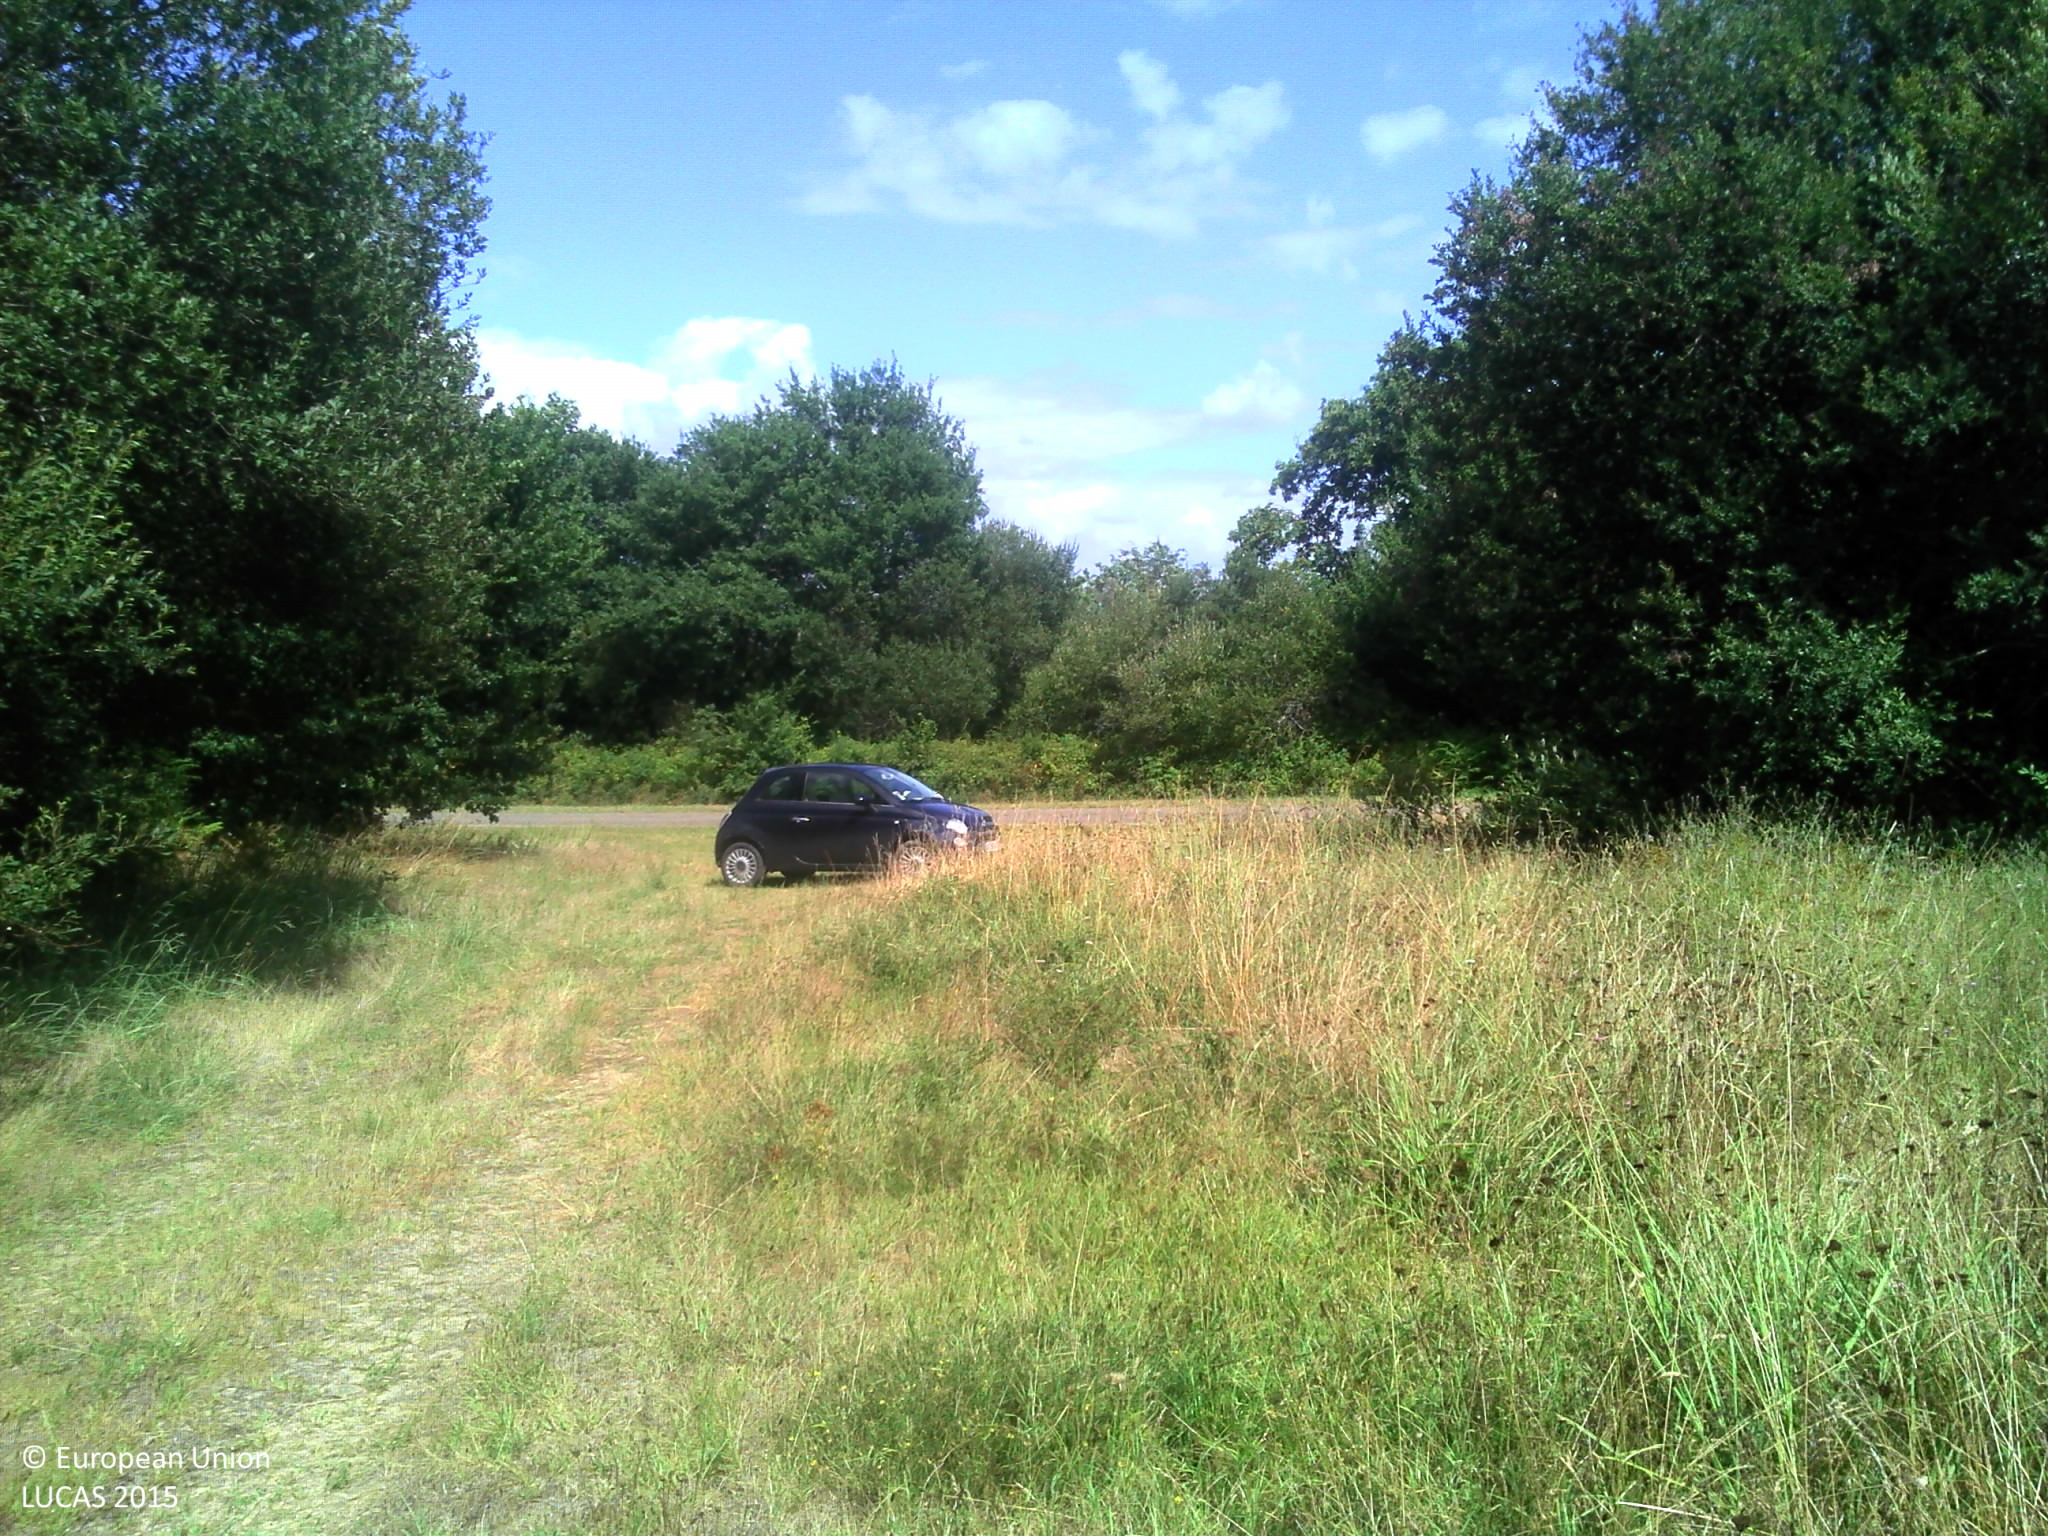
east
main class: Woodland
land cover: Broadleaved woodland
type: thermophilous deciduous forest
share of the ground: > 75 %
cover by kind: broadleaved forest trees 85 %, herbaceous plants 10 %, coniferous forest trees 5 %
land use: Forestry
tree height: > 5 m
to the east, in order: Broadleaved woodland; Rivers and streams; Broadleaved woodland; Grassland without tree/shrub cover; Broadleaved woodland; Grass margins; Tracks; Grass margins; Broadleaved woodland; Tracks; Grassland without tree/shrub cover
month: July
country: FR
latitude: 43.9801
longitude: -0.8492
